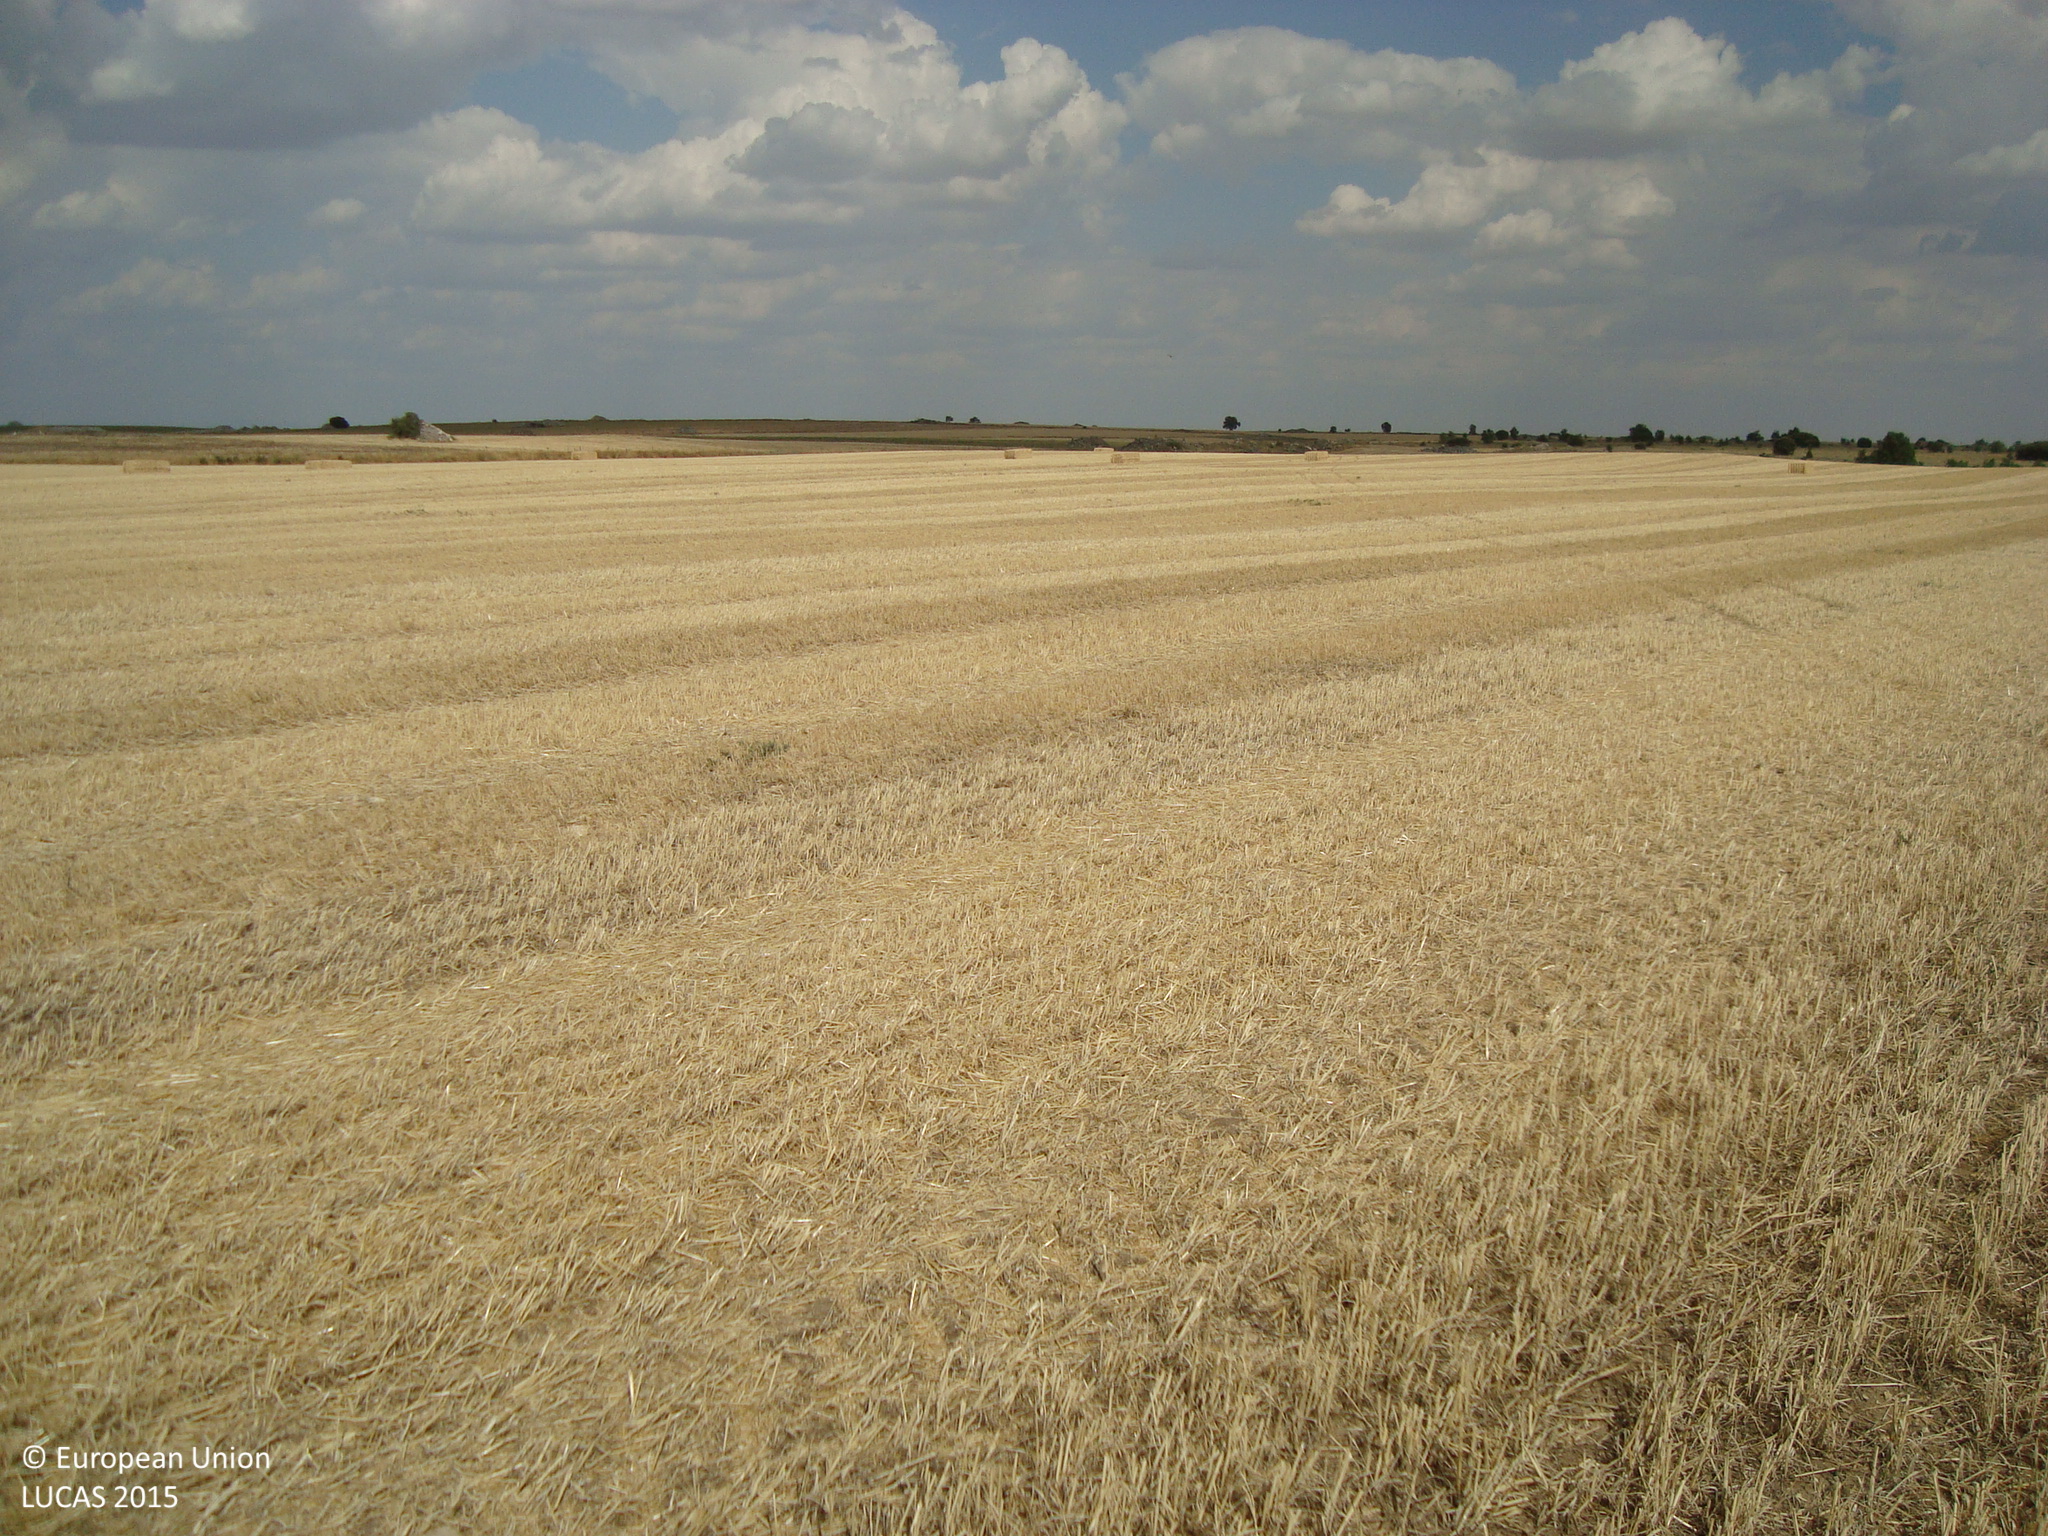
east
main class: Cropland
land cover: Barley
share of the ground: > 75 %
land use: Agriculture (excluding fallow land and kitchen gardens)
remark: Harvested field
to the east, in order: Barley
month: July
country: ES
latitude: 41.9914
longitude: -4.1016
